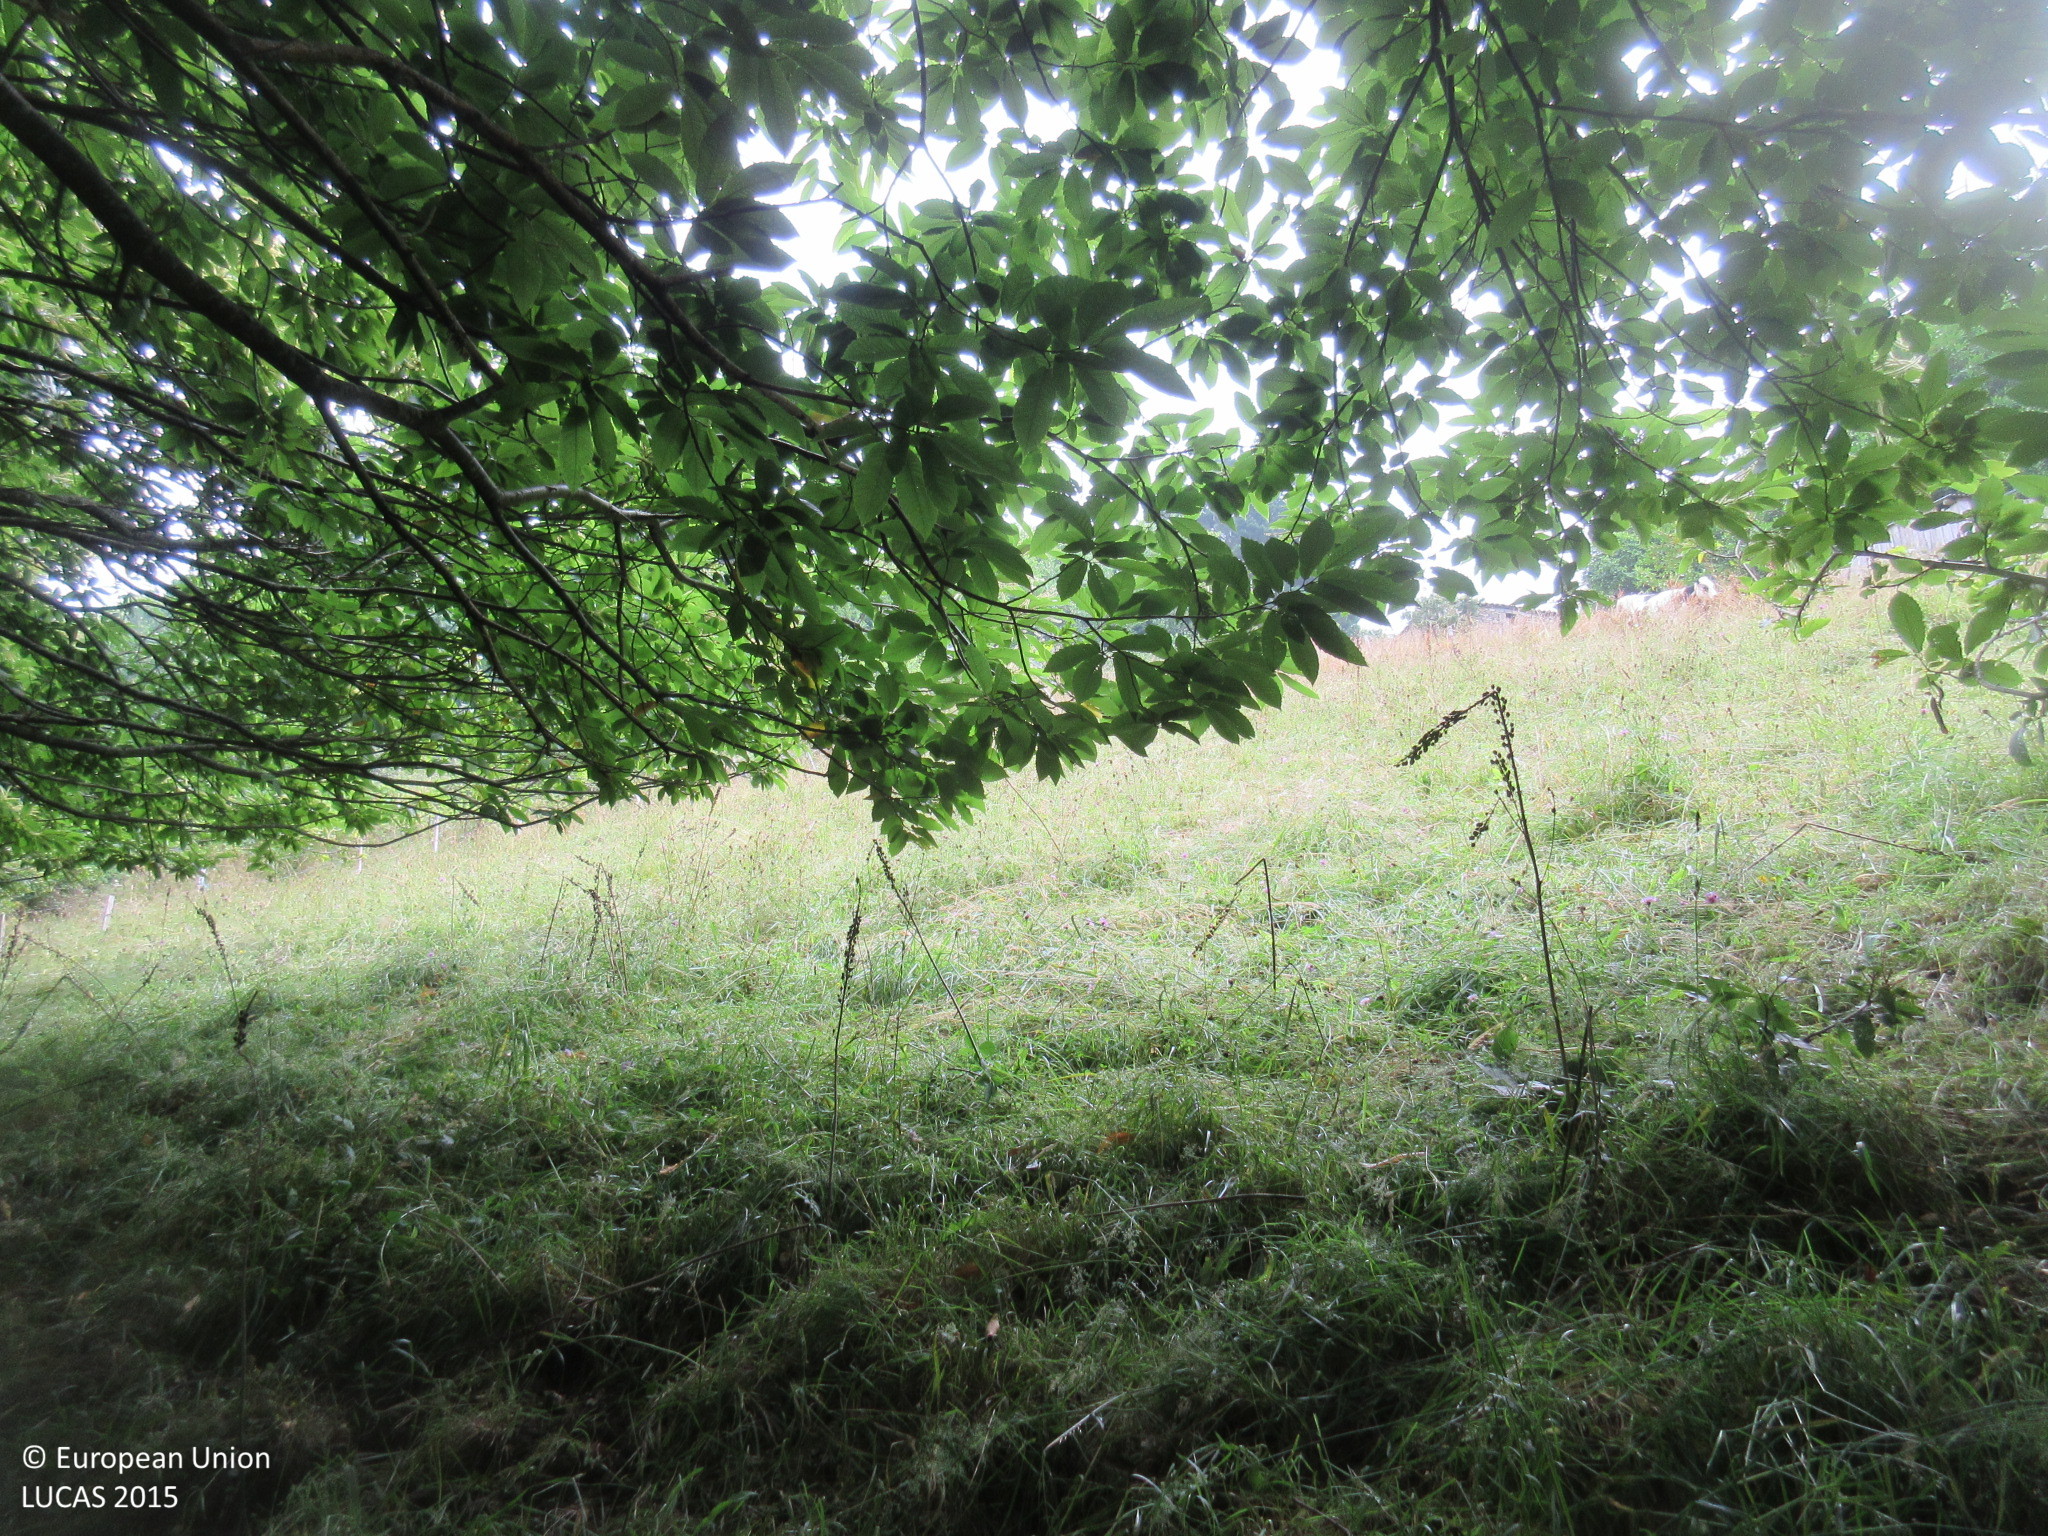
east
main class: Woodland
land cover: Broadleaved woodland
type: thermophilous deciduous forest
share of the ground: > 75 %
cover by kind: broadleaved forest trees 100 %
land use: Forestry
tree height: > 5 m
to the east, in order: Broadleaved woodland; Grassland without tree/shrub cover; Fences; Shrubland without tree cover; Grass margins; Paved roads, cycling and walking lanes; Broadleaved woodland; Grassland without tree/shrub cover; Broadleaved woodland; Grassland without tree/shrub cover
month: July
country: ES
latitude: 43.4689
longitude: -6.3303
